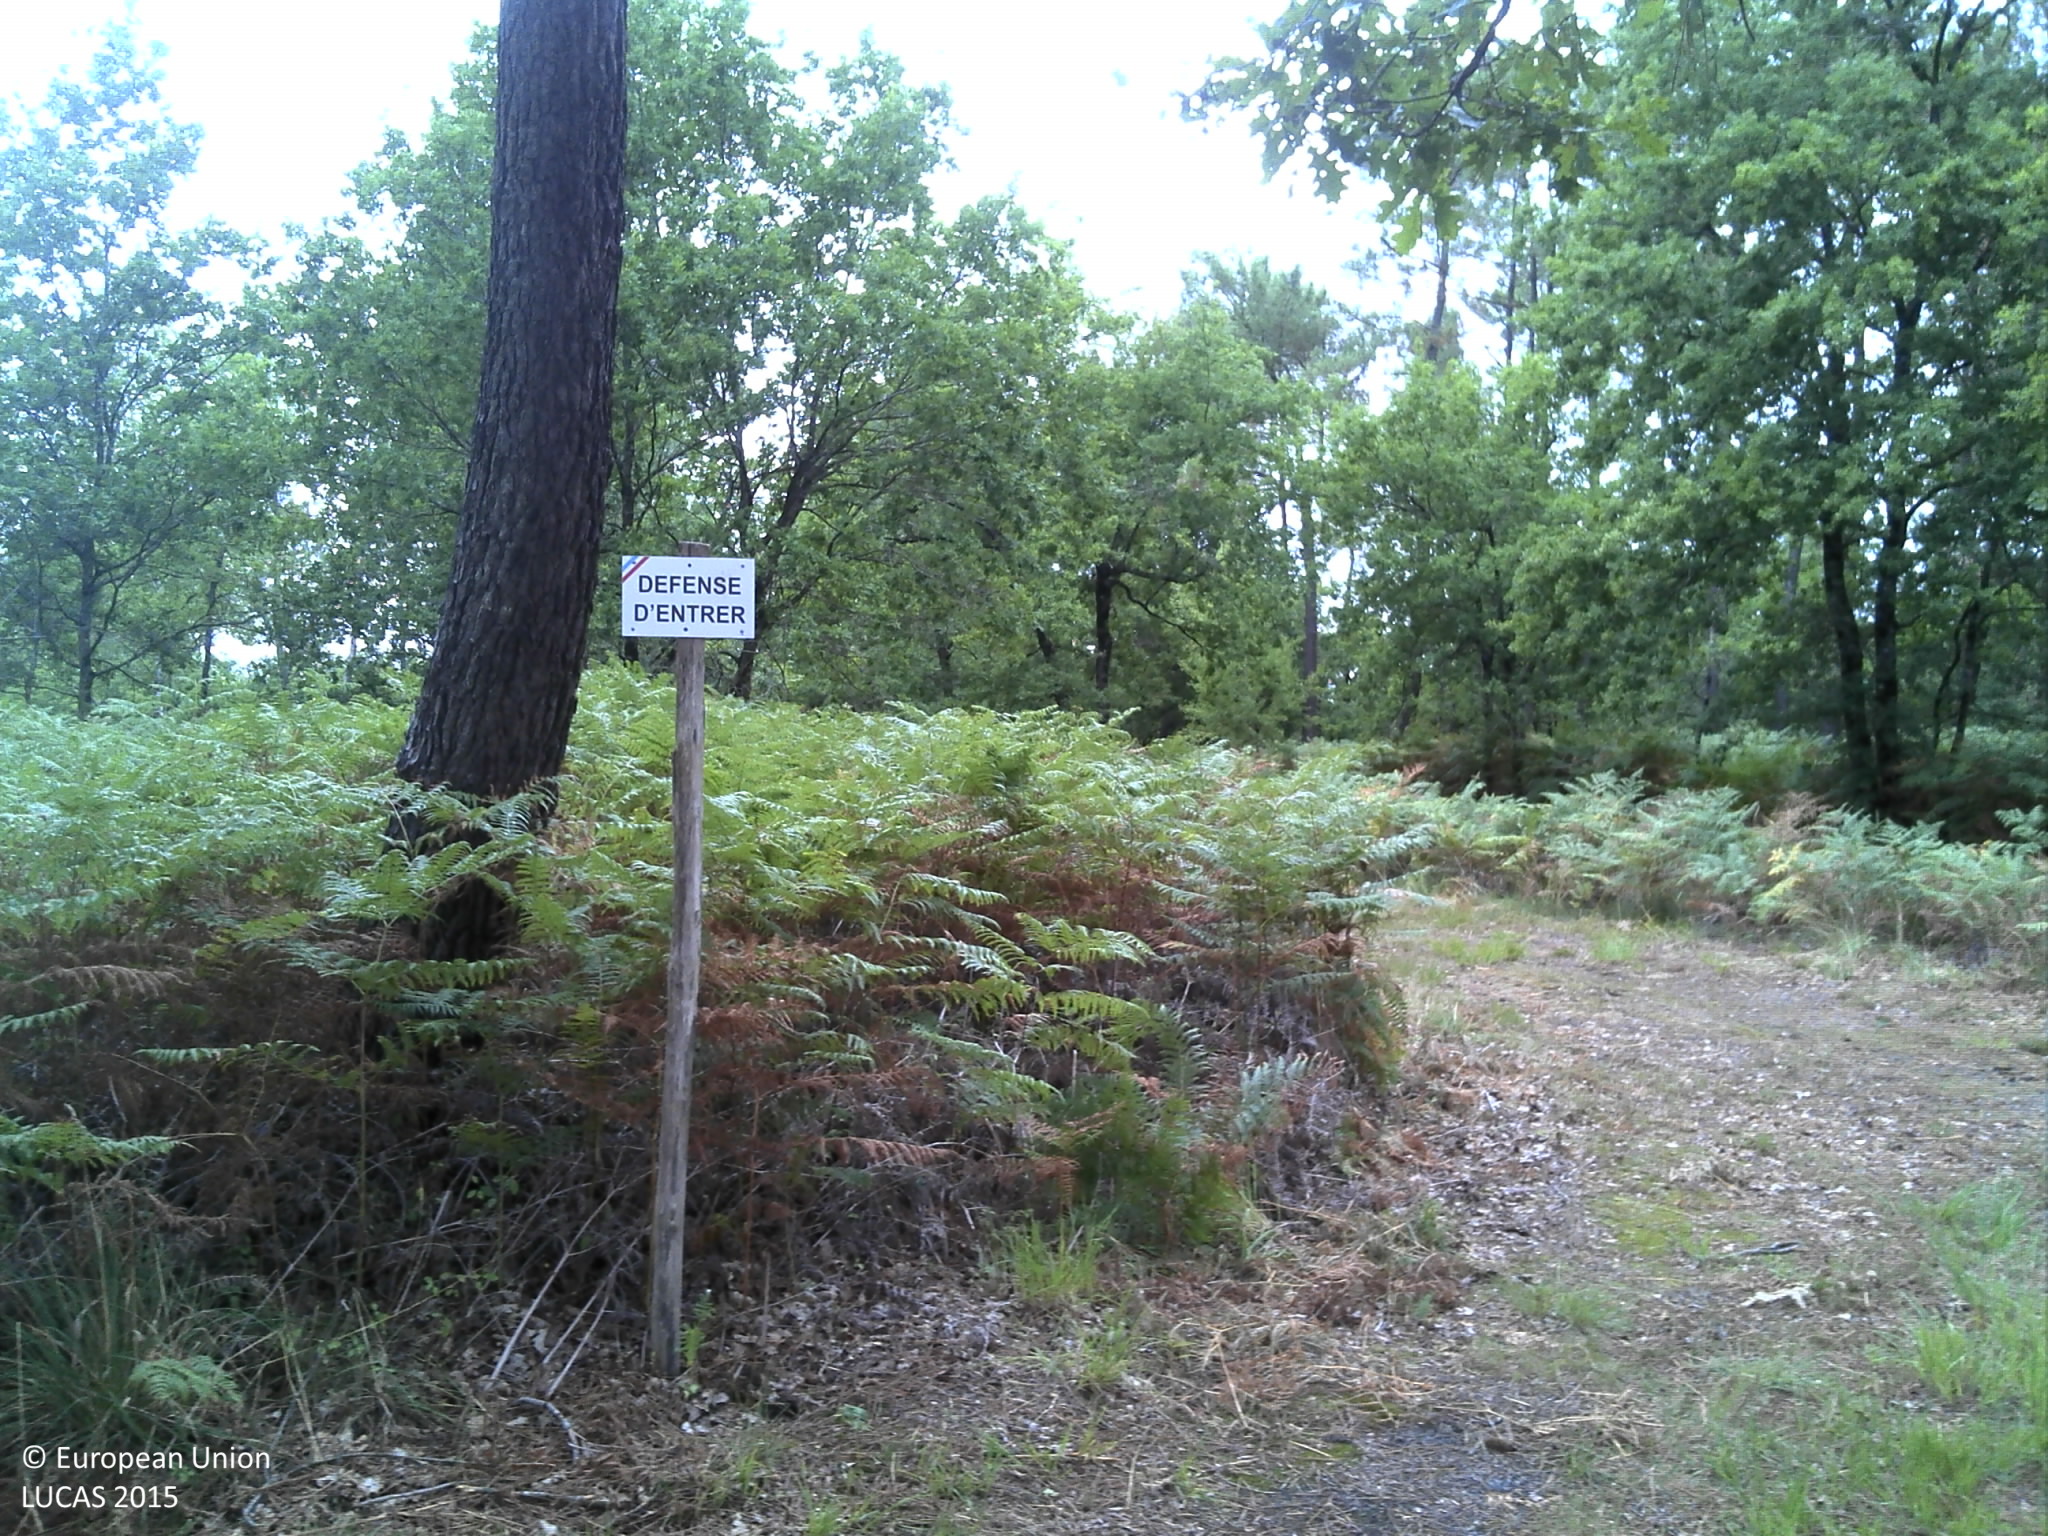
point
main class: Woodland
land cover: Pine dominated coniferous woodland
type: coniferous forest of the mediterranean region
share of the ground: > 75 %
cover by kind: coniferous forest trees 60 %, shrubs 30 %, herbaceous plants 5 %, lichens and mosses 5 %
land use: Forestry
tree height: > 5 m
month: August
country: FR
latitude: 44.7011
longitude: -0.7339
